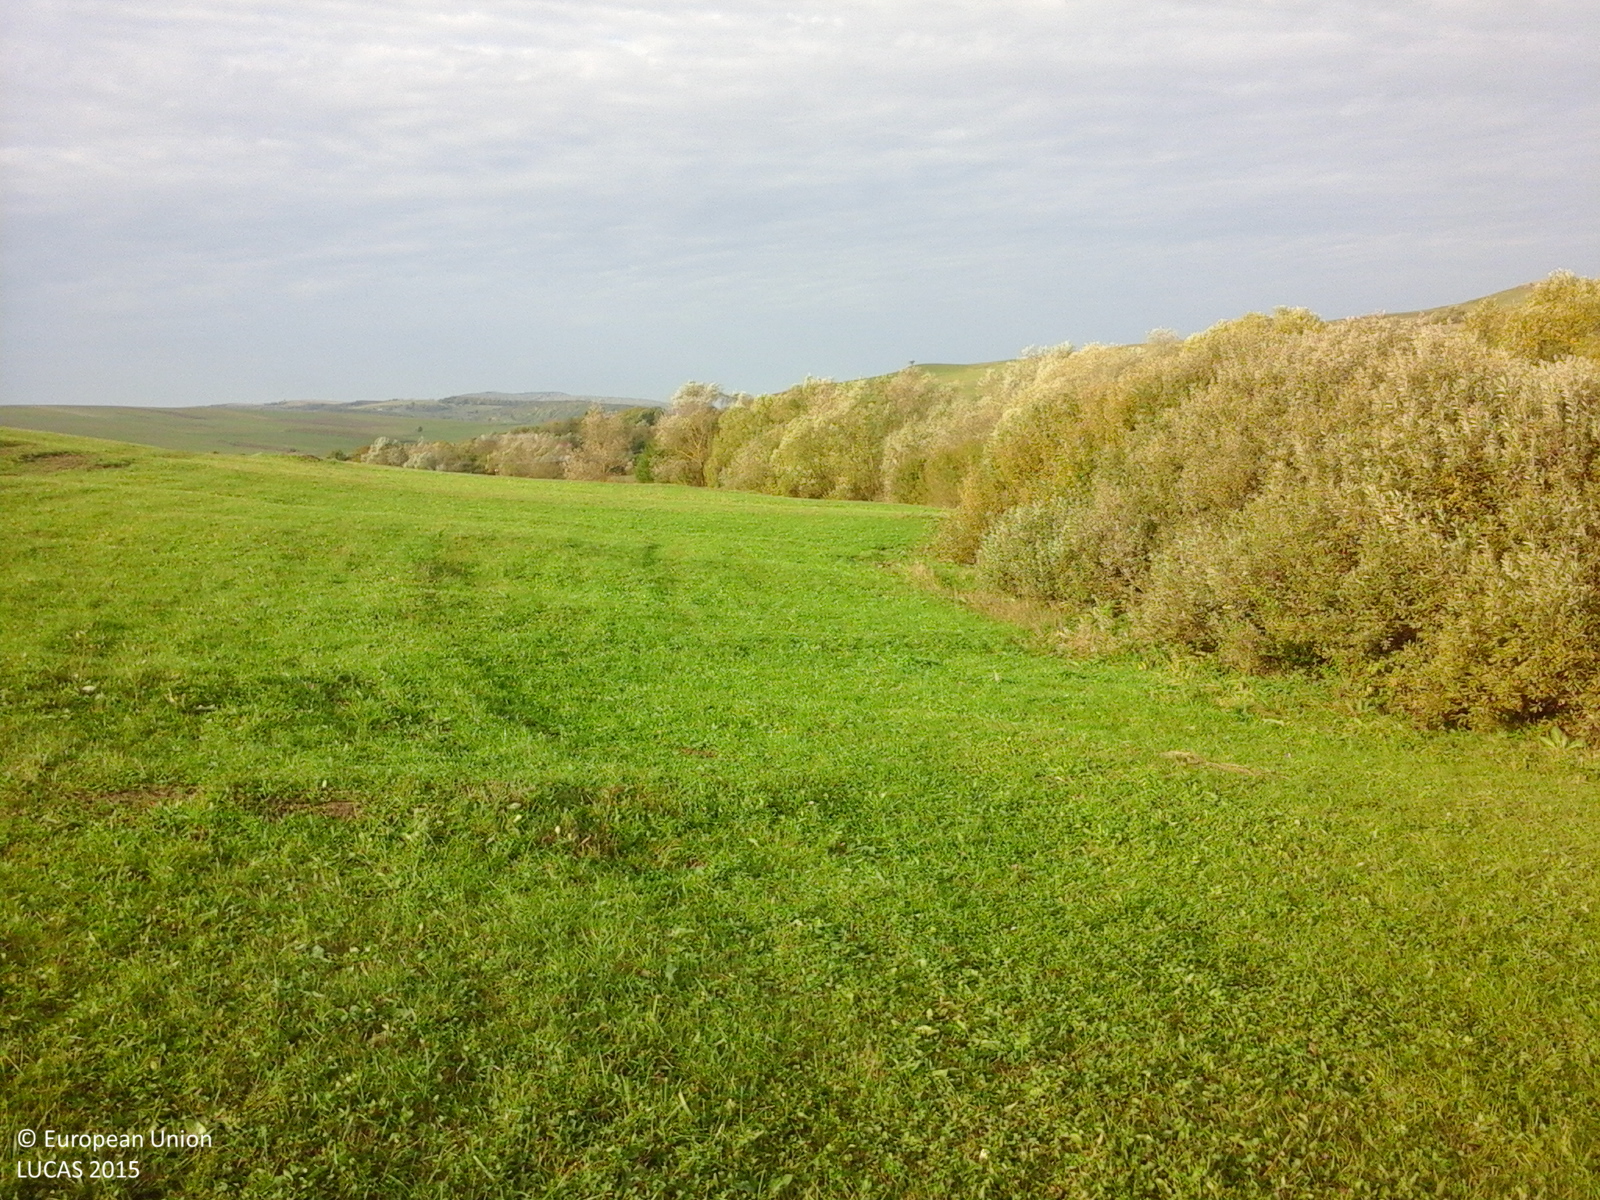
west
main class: Grassland
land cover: Grassland without tree/shrub cover
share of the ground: > 75 %
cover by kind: herbaceous plants 100 %
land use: Agriculture (excluding fallow land and kitchen gardens)
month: October
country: RO
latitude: 46.3602
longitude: 25.2966
